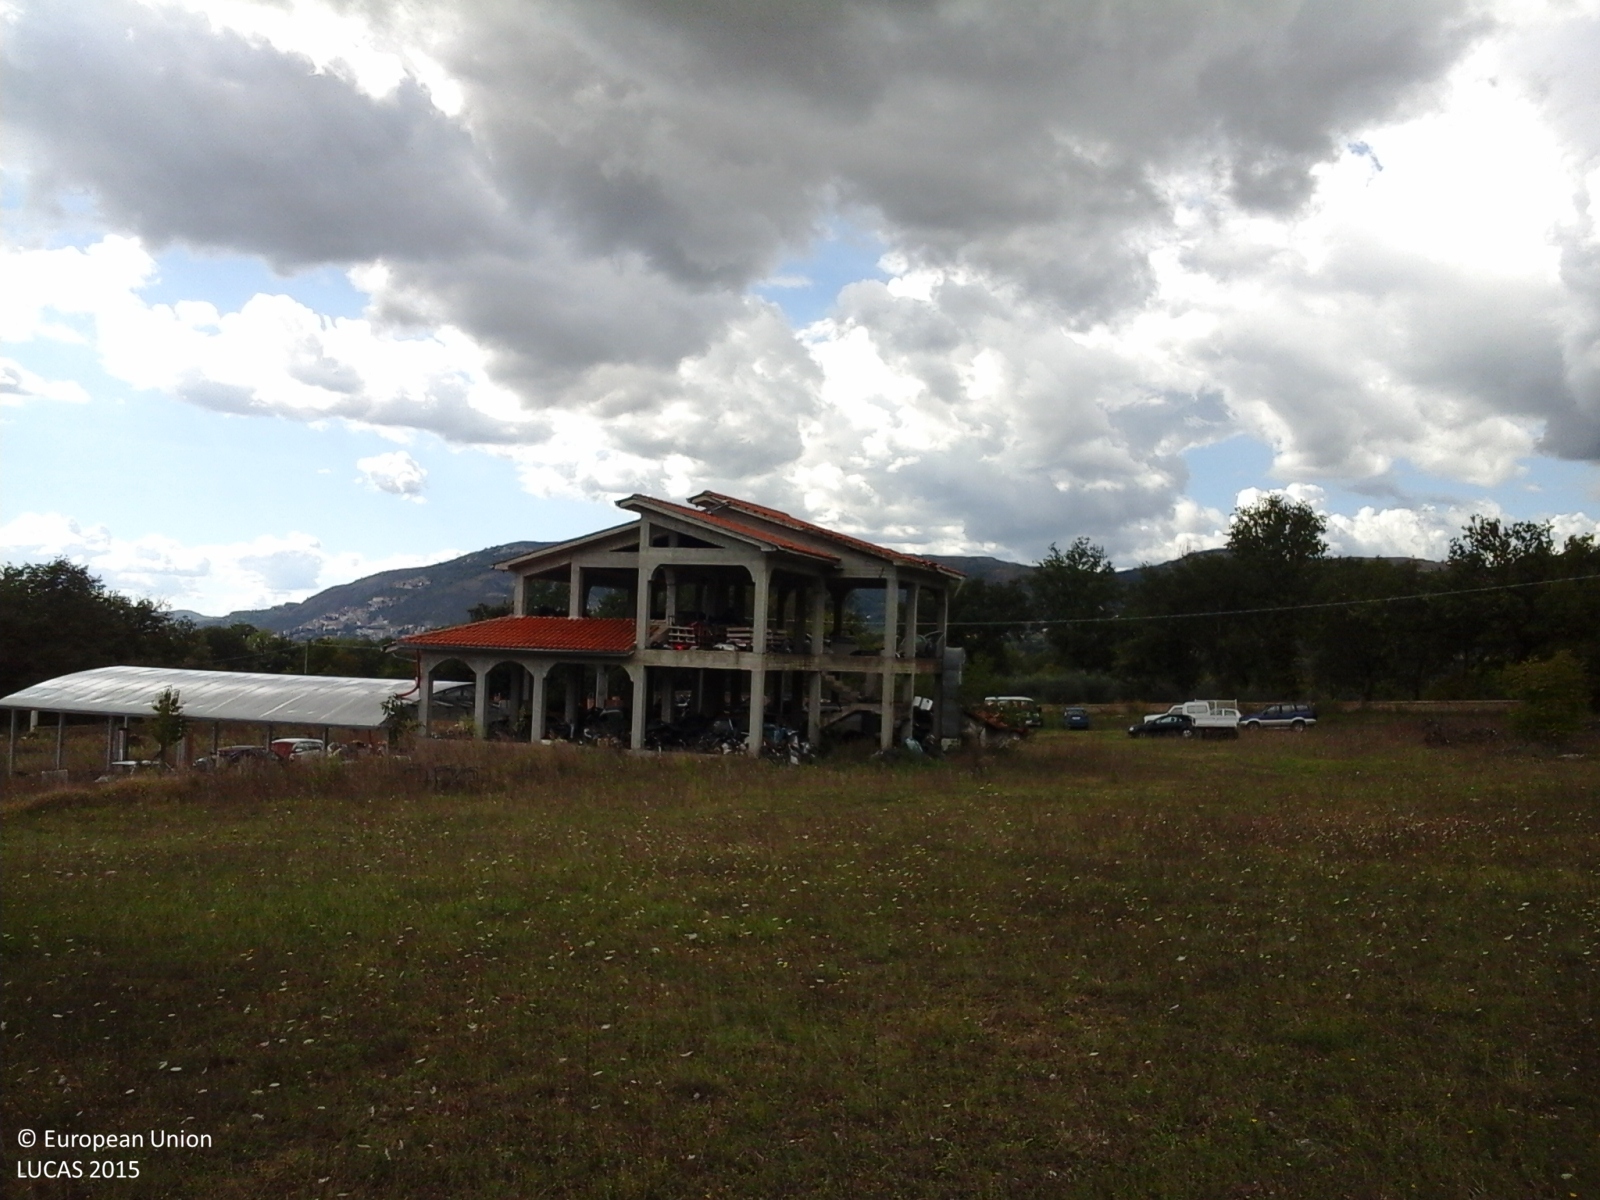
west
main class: Grassland
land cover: Grassland without tree/shrub cover
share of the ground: > 75 %
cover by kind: herbaceous plants 100 %
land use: Agriculture (excluding fallow land and kitchen gardens)
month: September
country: IT
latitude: 41.6967
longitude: 13.7953
